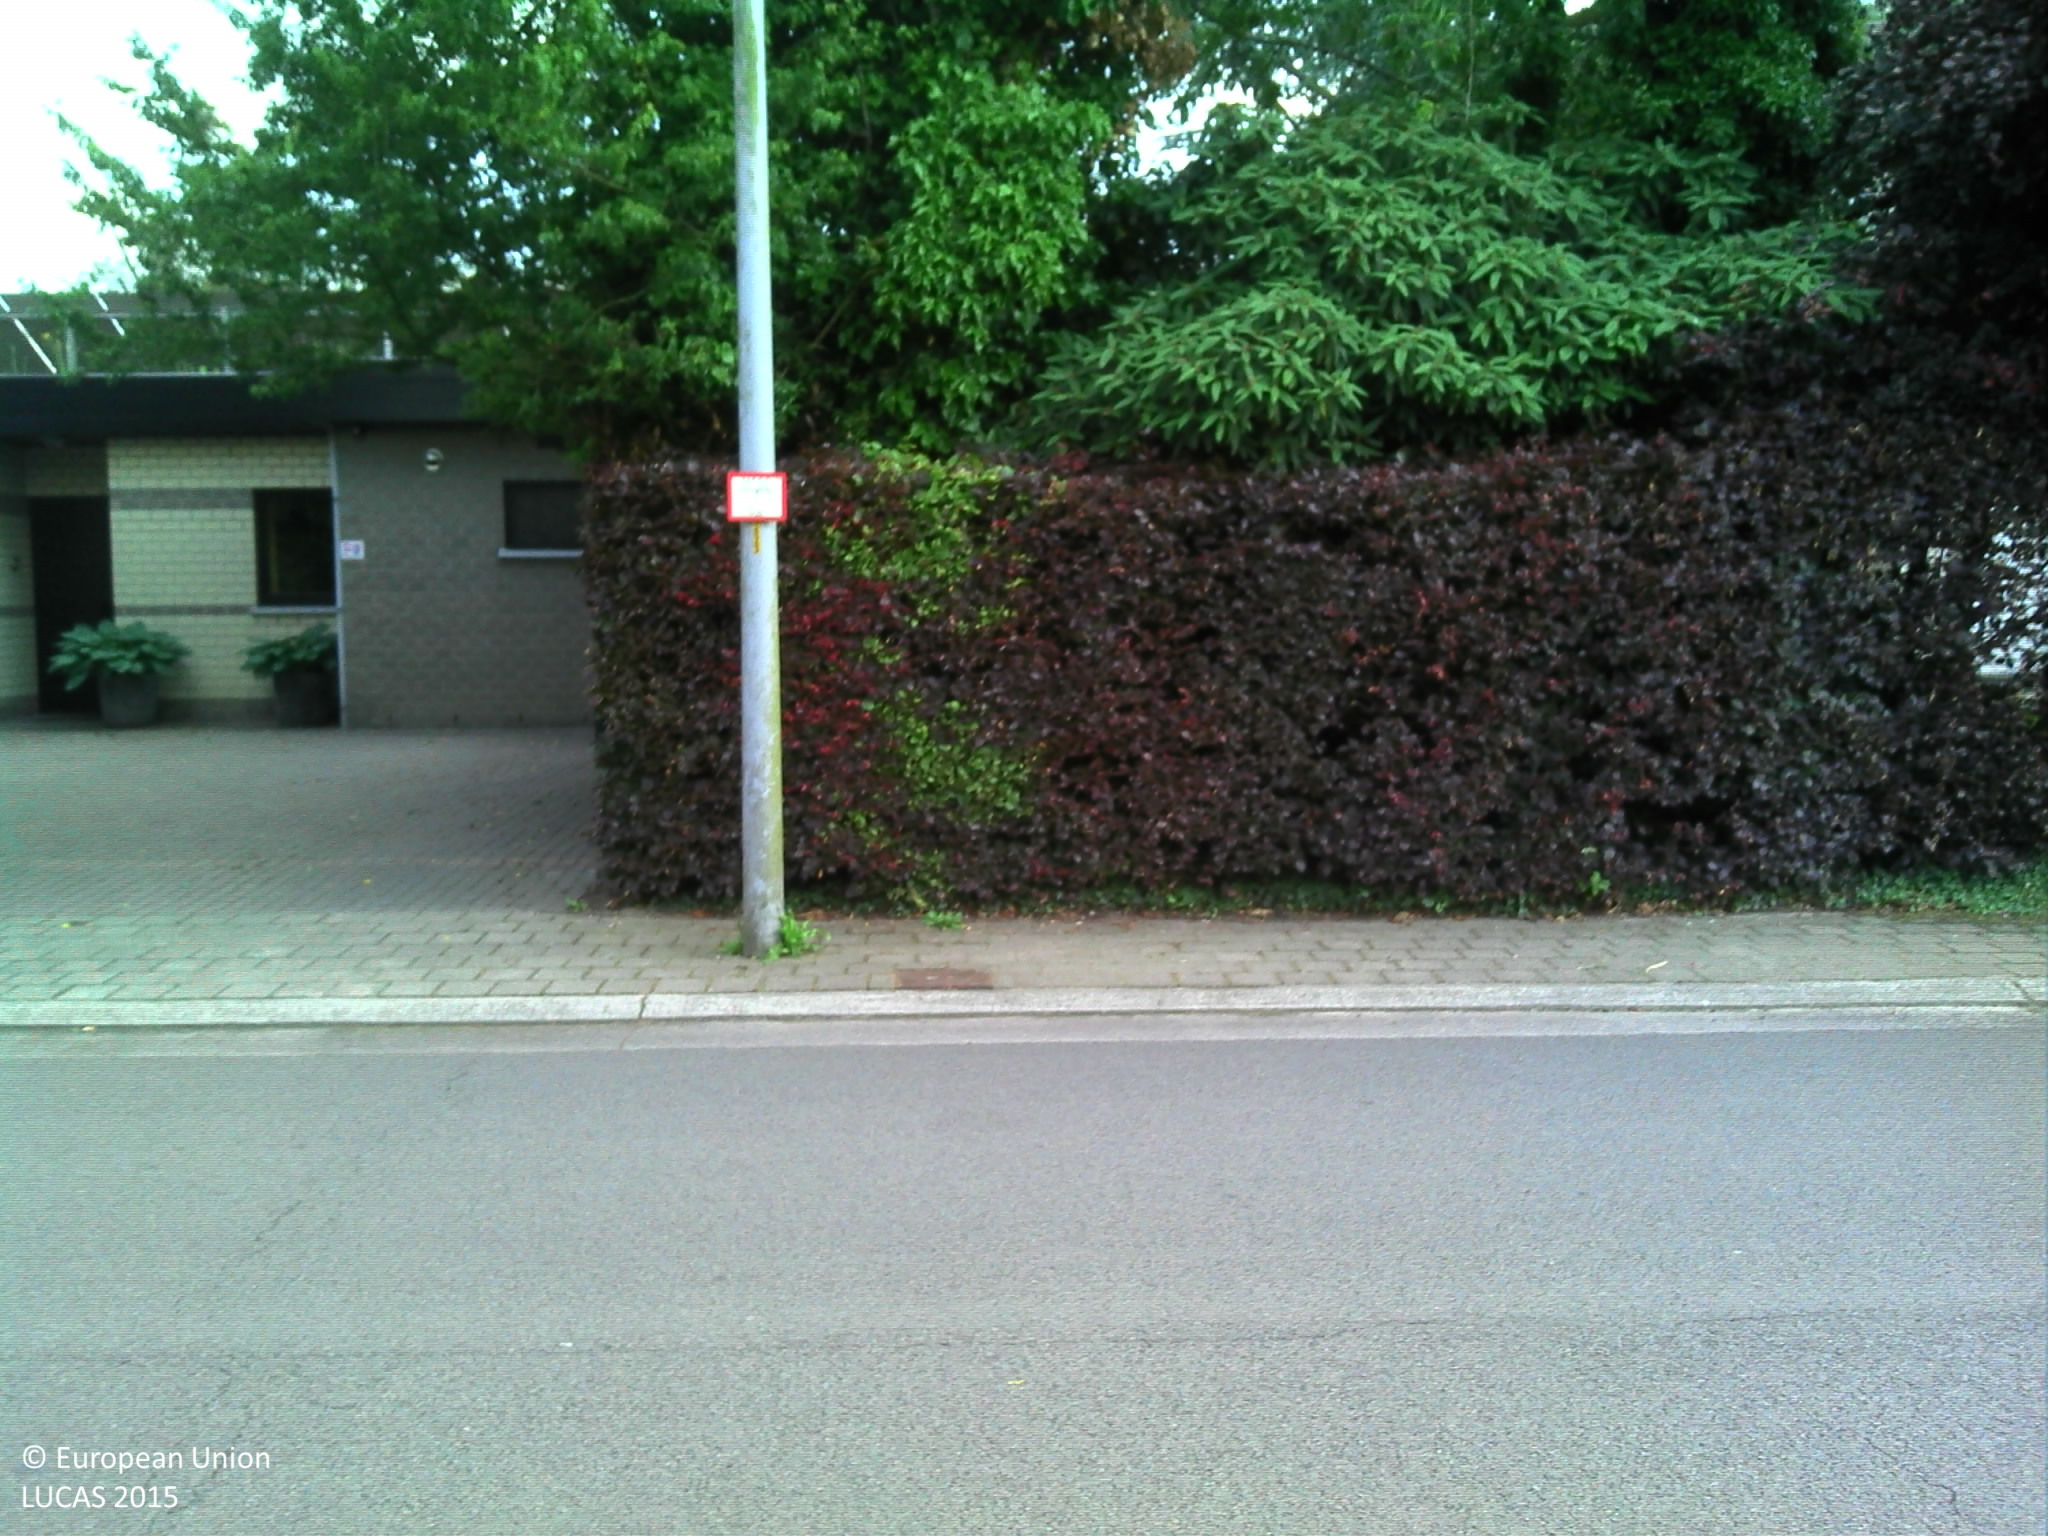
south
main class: Grassland
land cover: Grassland without tree/shrub cover
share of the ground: > 75 %
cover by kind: herbaceous plants 100 %
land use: Agriculture (excluding fallow land and kitchen gardens)
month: June
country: BE
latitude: 51.0623
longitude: 3.8150
